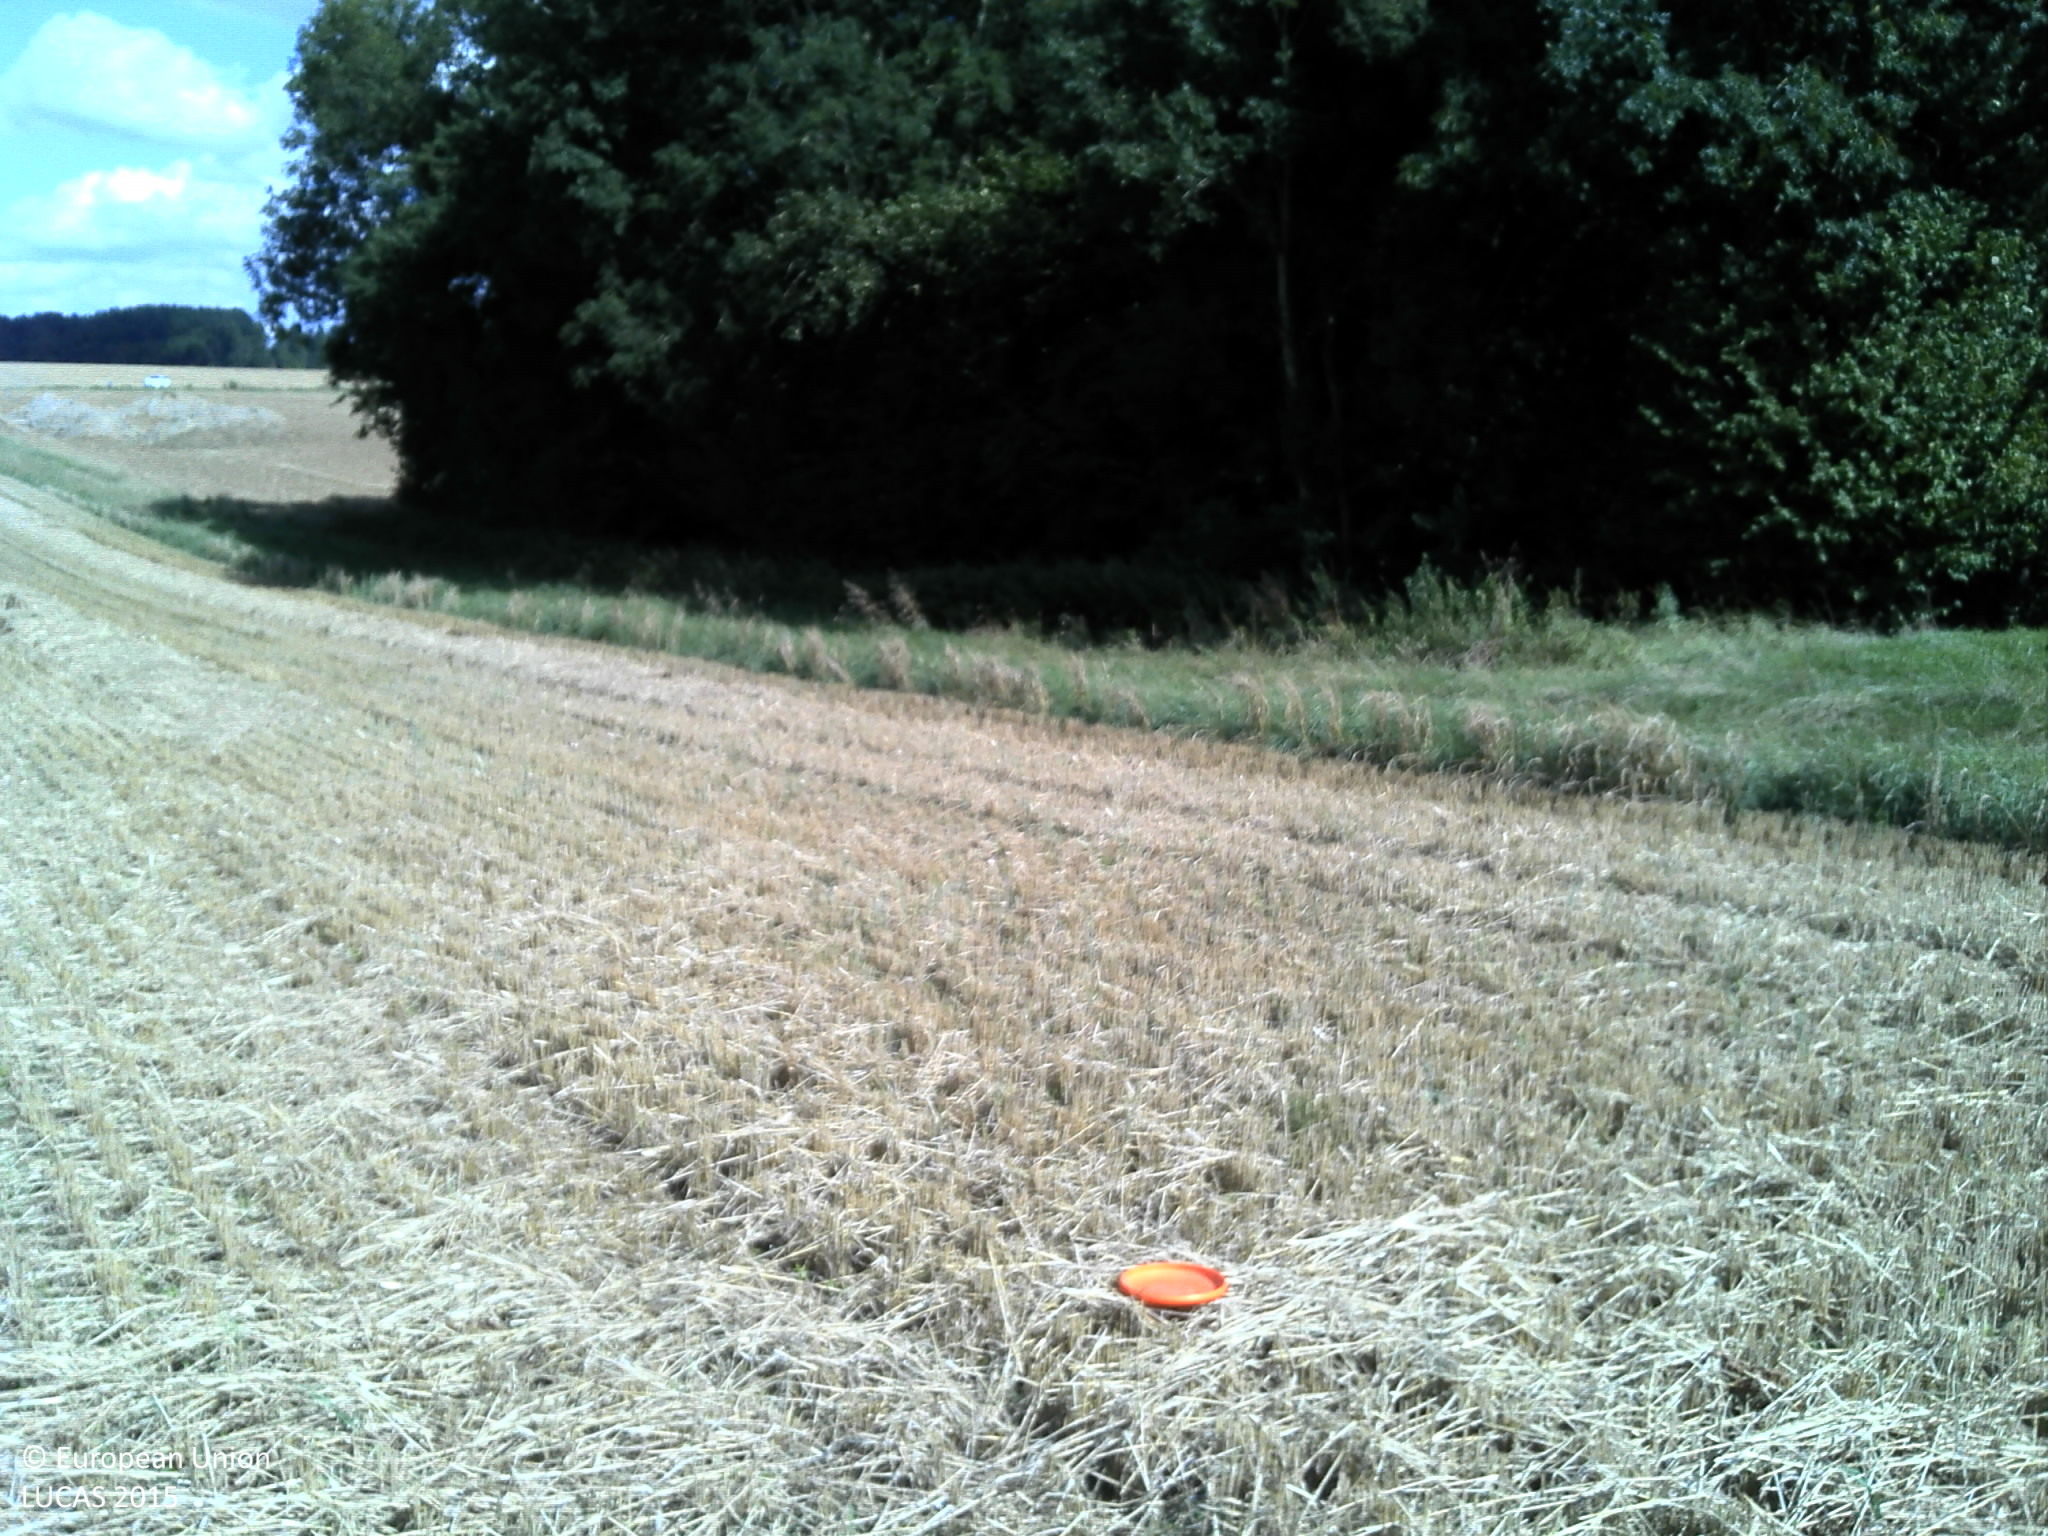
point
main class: Cropland
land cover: Barley
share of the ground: 10 - 25 %
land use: Agriculture (excluding fallow land and kitchen gardens)
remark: Harvested field
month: August
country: FR
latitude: 49.9778
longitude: 3.1441
